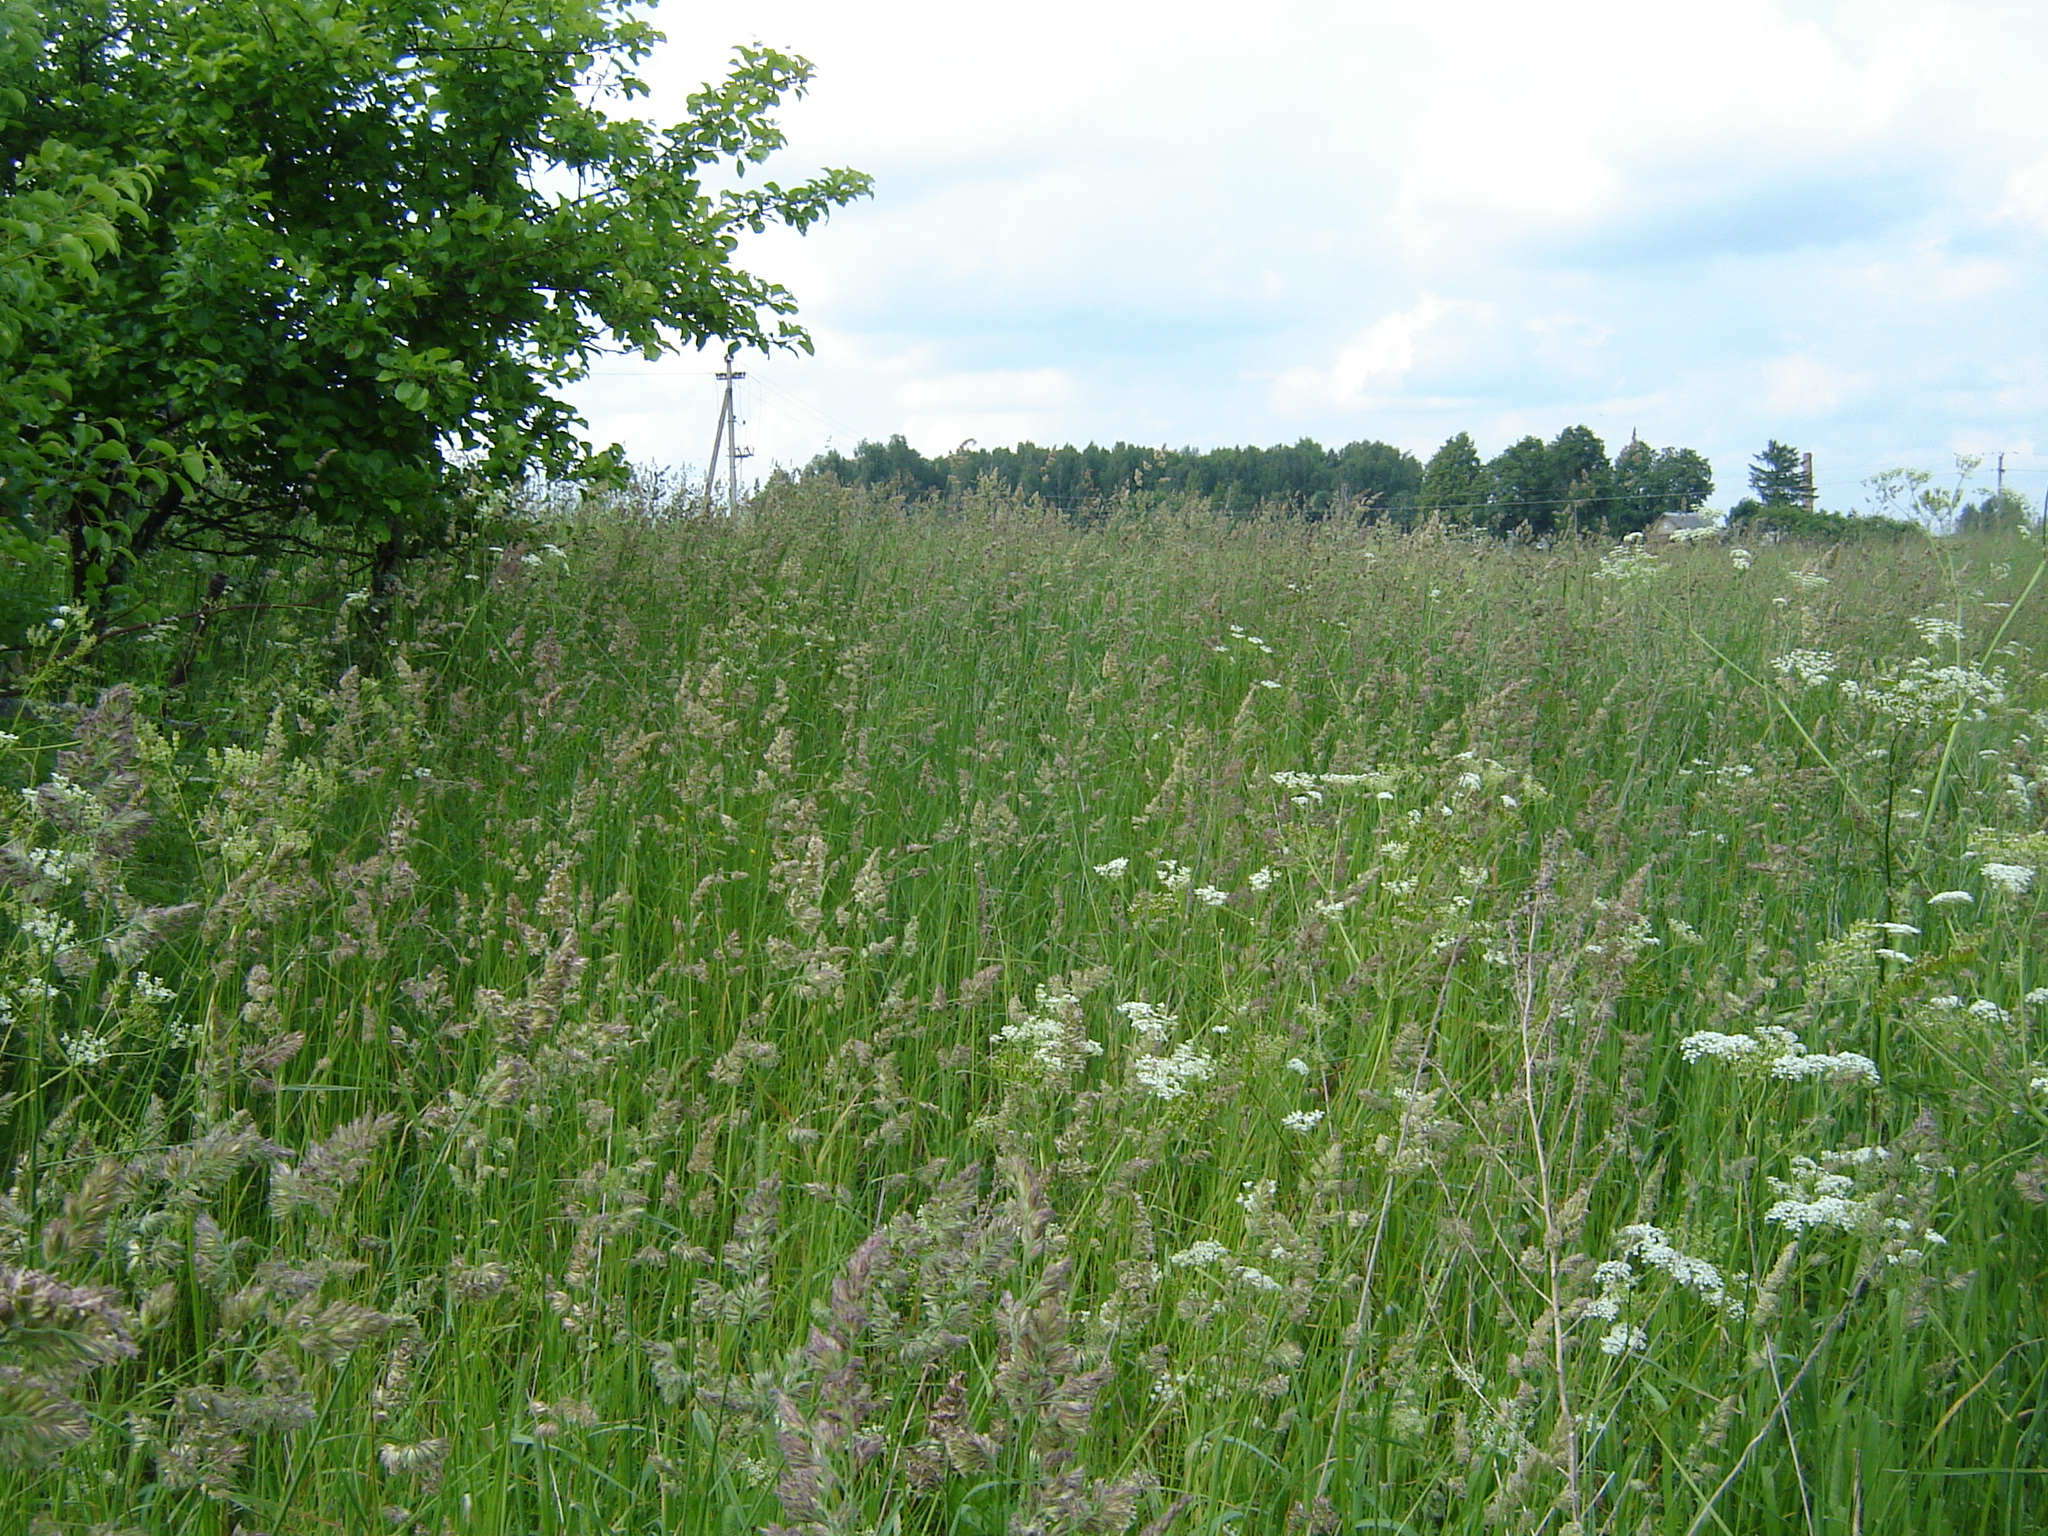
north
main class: Grassland
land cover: Grassland without tree/shrub cover
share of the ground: > 75 %
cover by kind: herbaceous plants 100 %
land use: Agriculture (excluding fallow land and kitchen gardens)
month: June
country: LT
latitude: 55.4776
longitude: 25.4870
